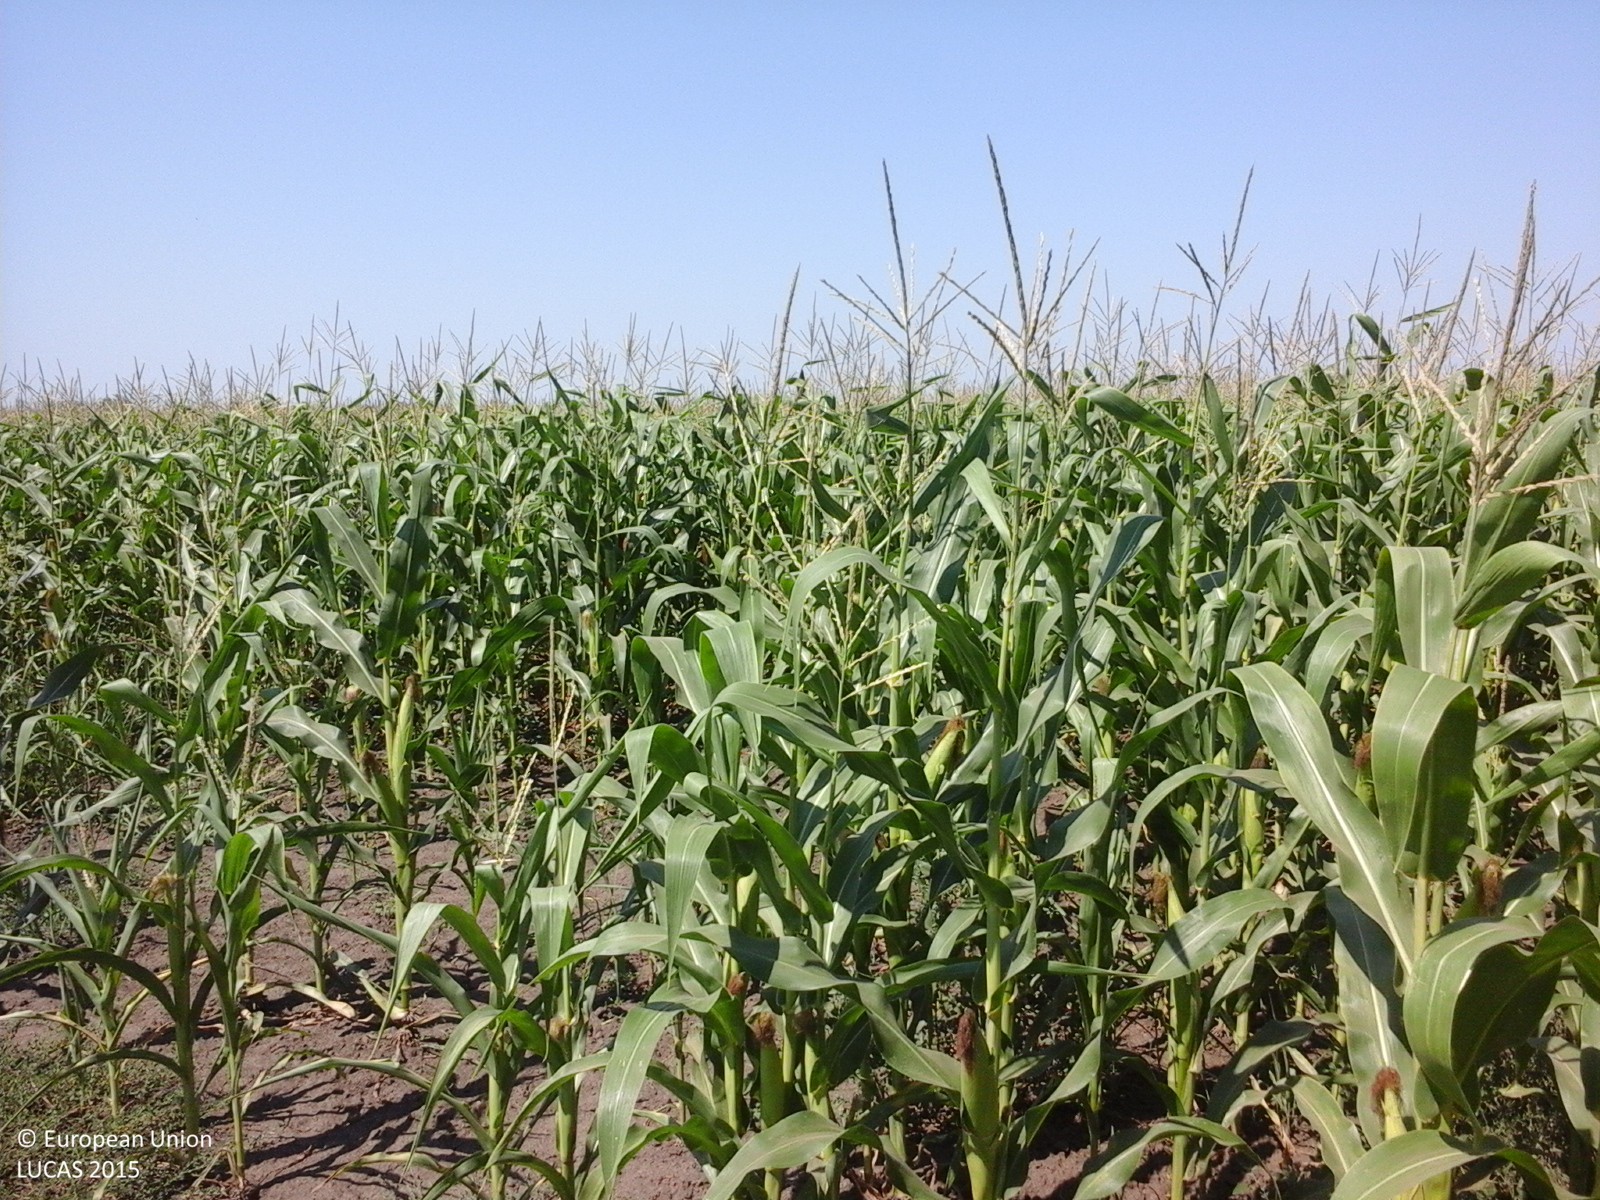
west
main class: Cropland
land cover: Maize
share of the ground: > 75 %
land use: Agriculture (excluding fallow land and kitchen gardens)
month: July
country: RO
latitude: 44.3315
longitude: 27.1233
